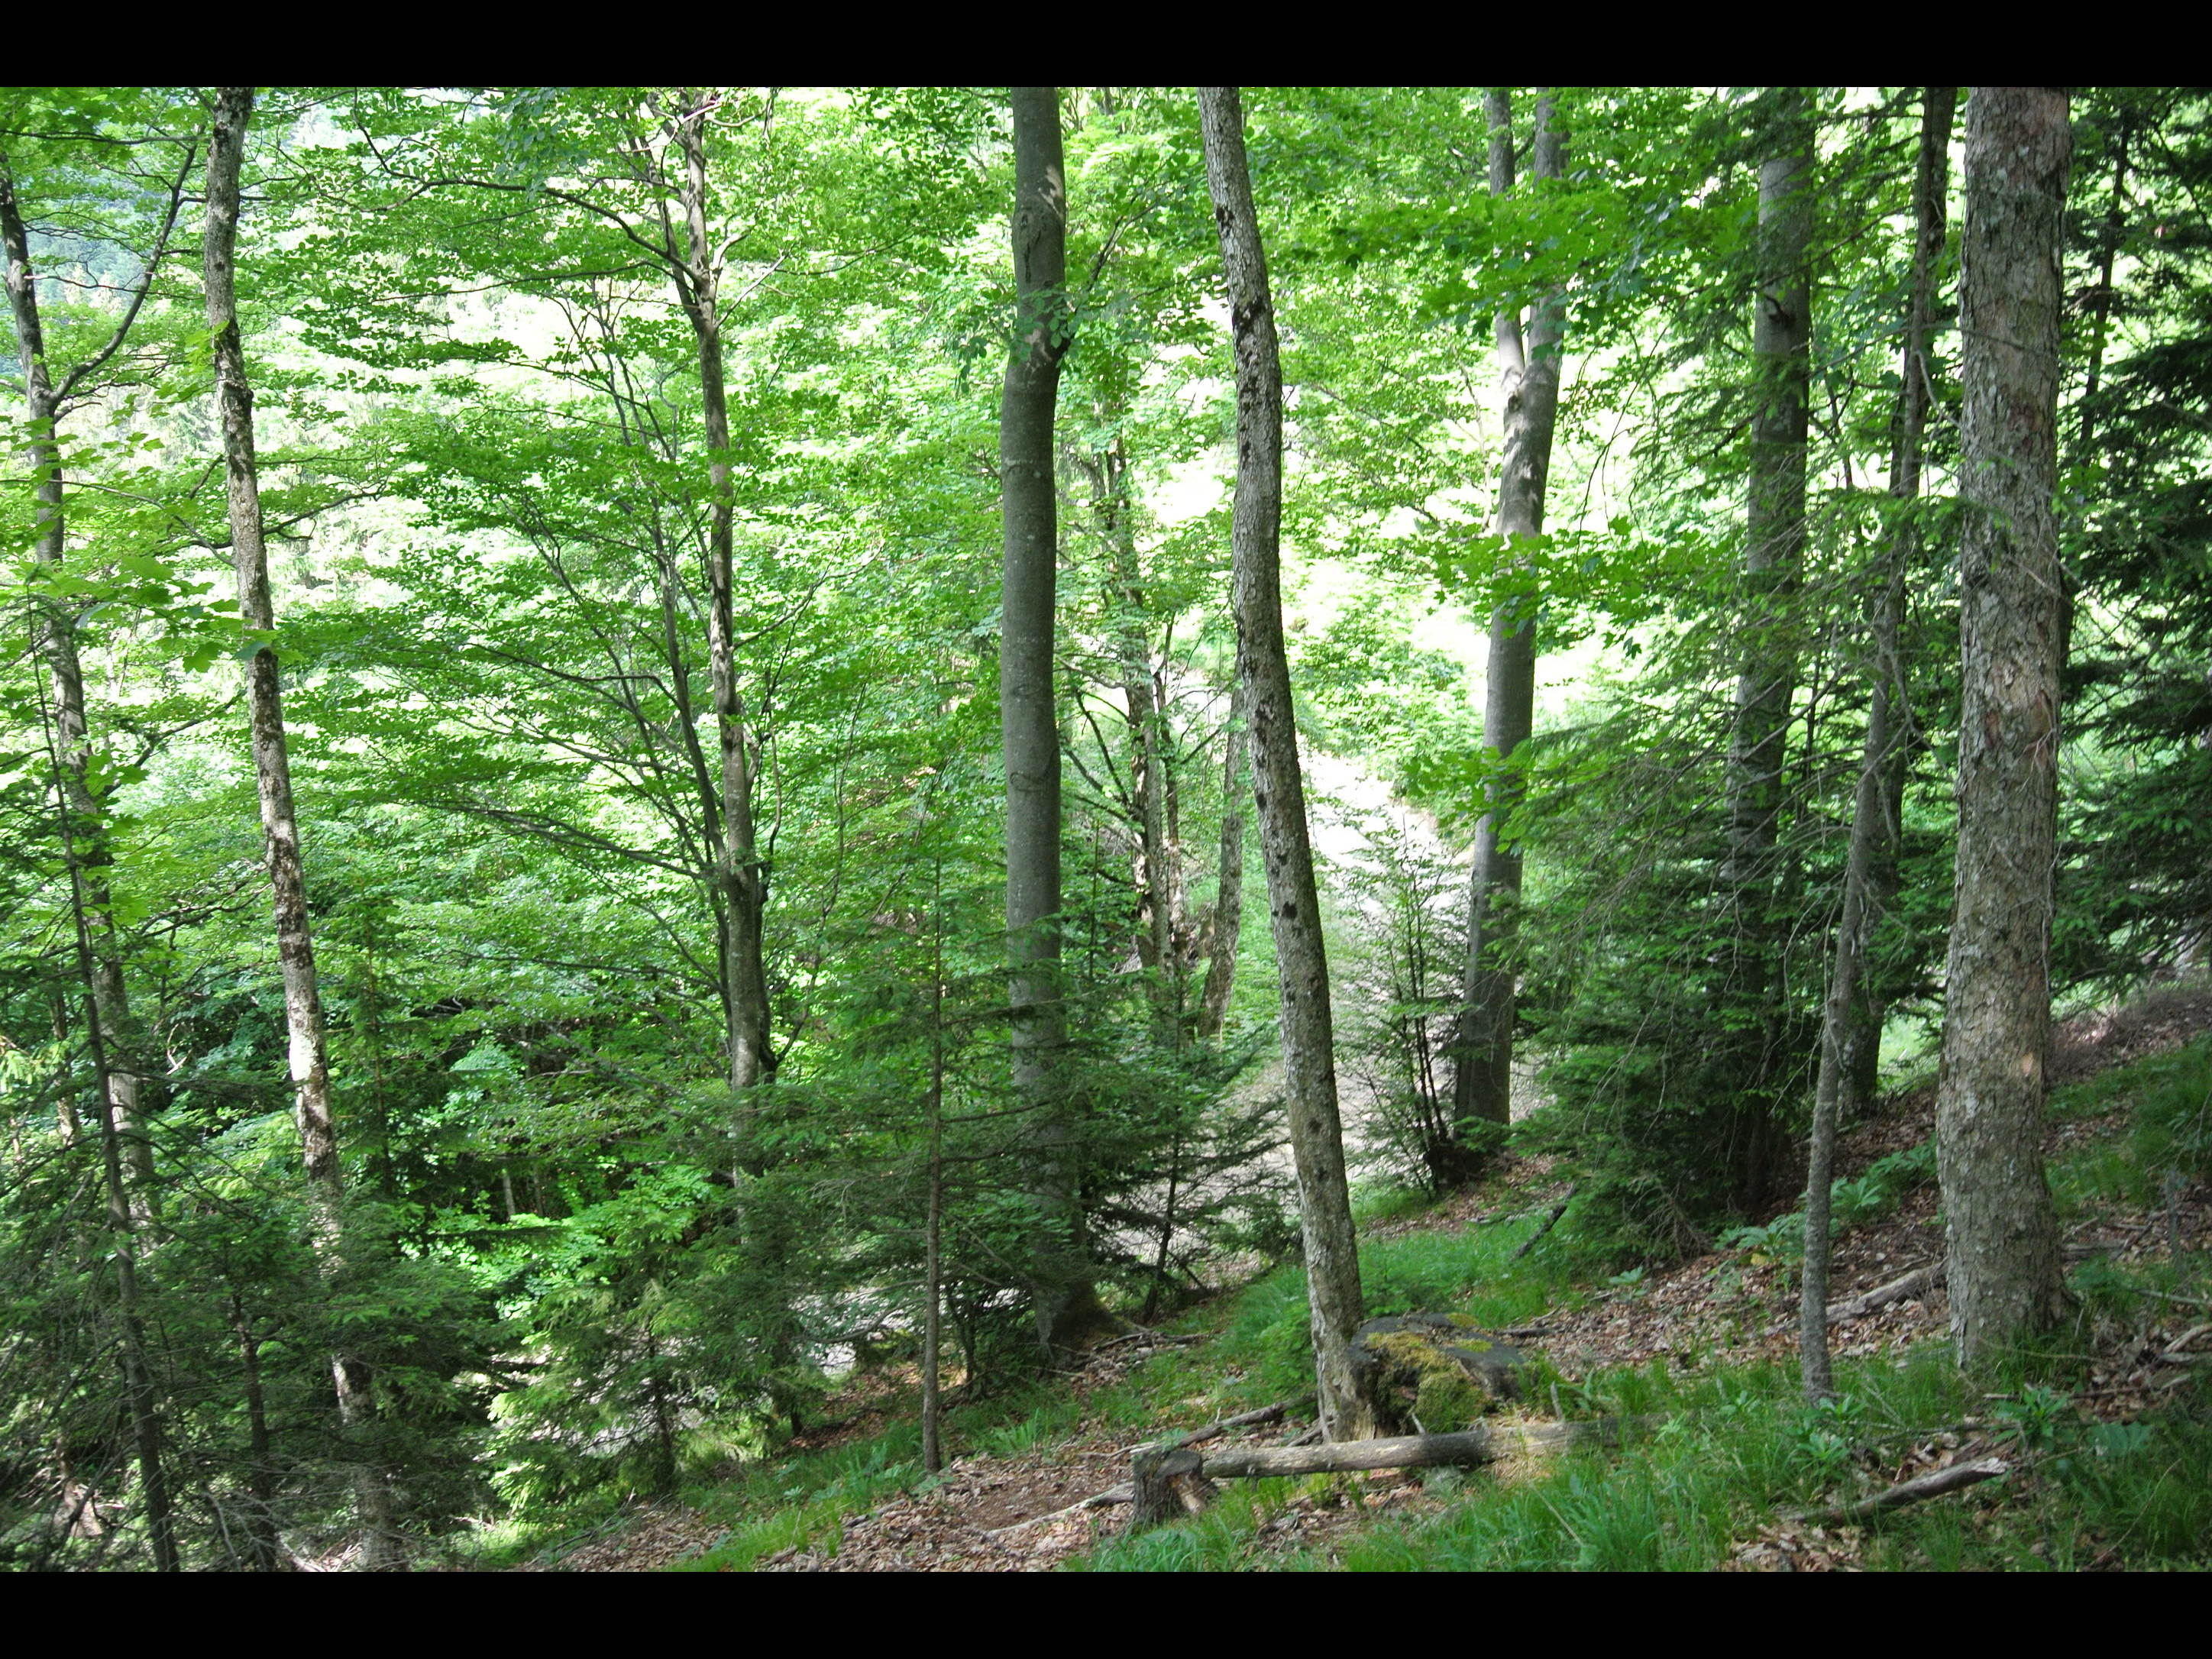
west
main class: Woodland
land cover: Other mixed woodland
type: alpine coniferous forest
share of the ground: > 75 %
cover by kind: broadleaved forest trees 70 %, coniferous forest trees 30 %
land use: Forestry
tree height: > 5 m
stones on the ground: < 10 %
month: June
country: AT
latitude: 47.9115
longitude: 15.7423
